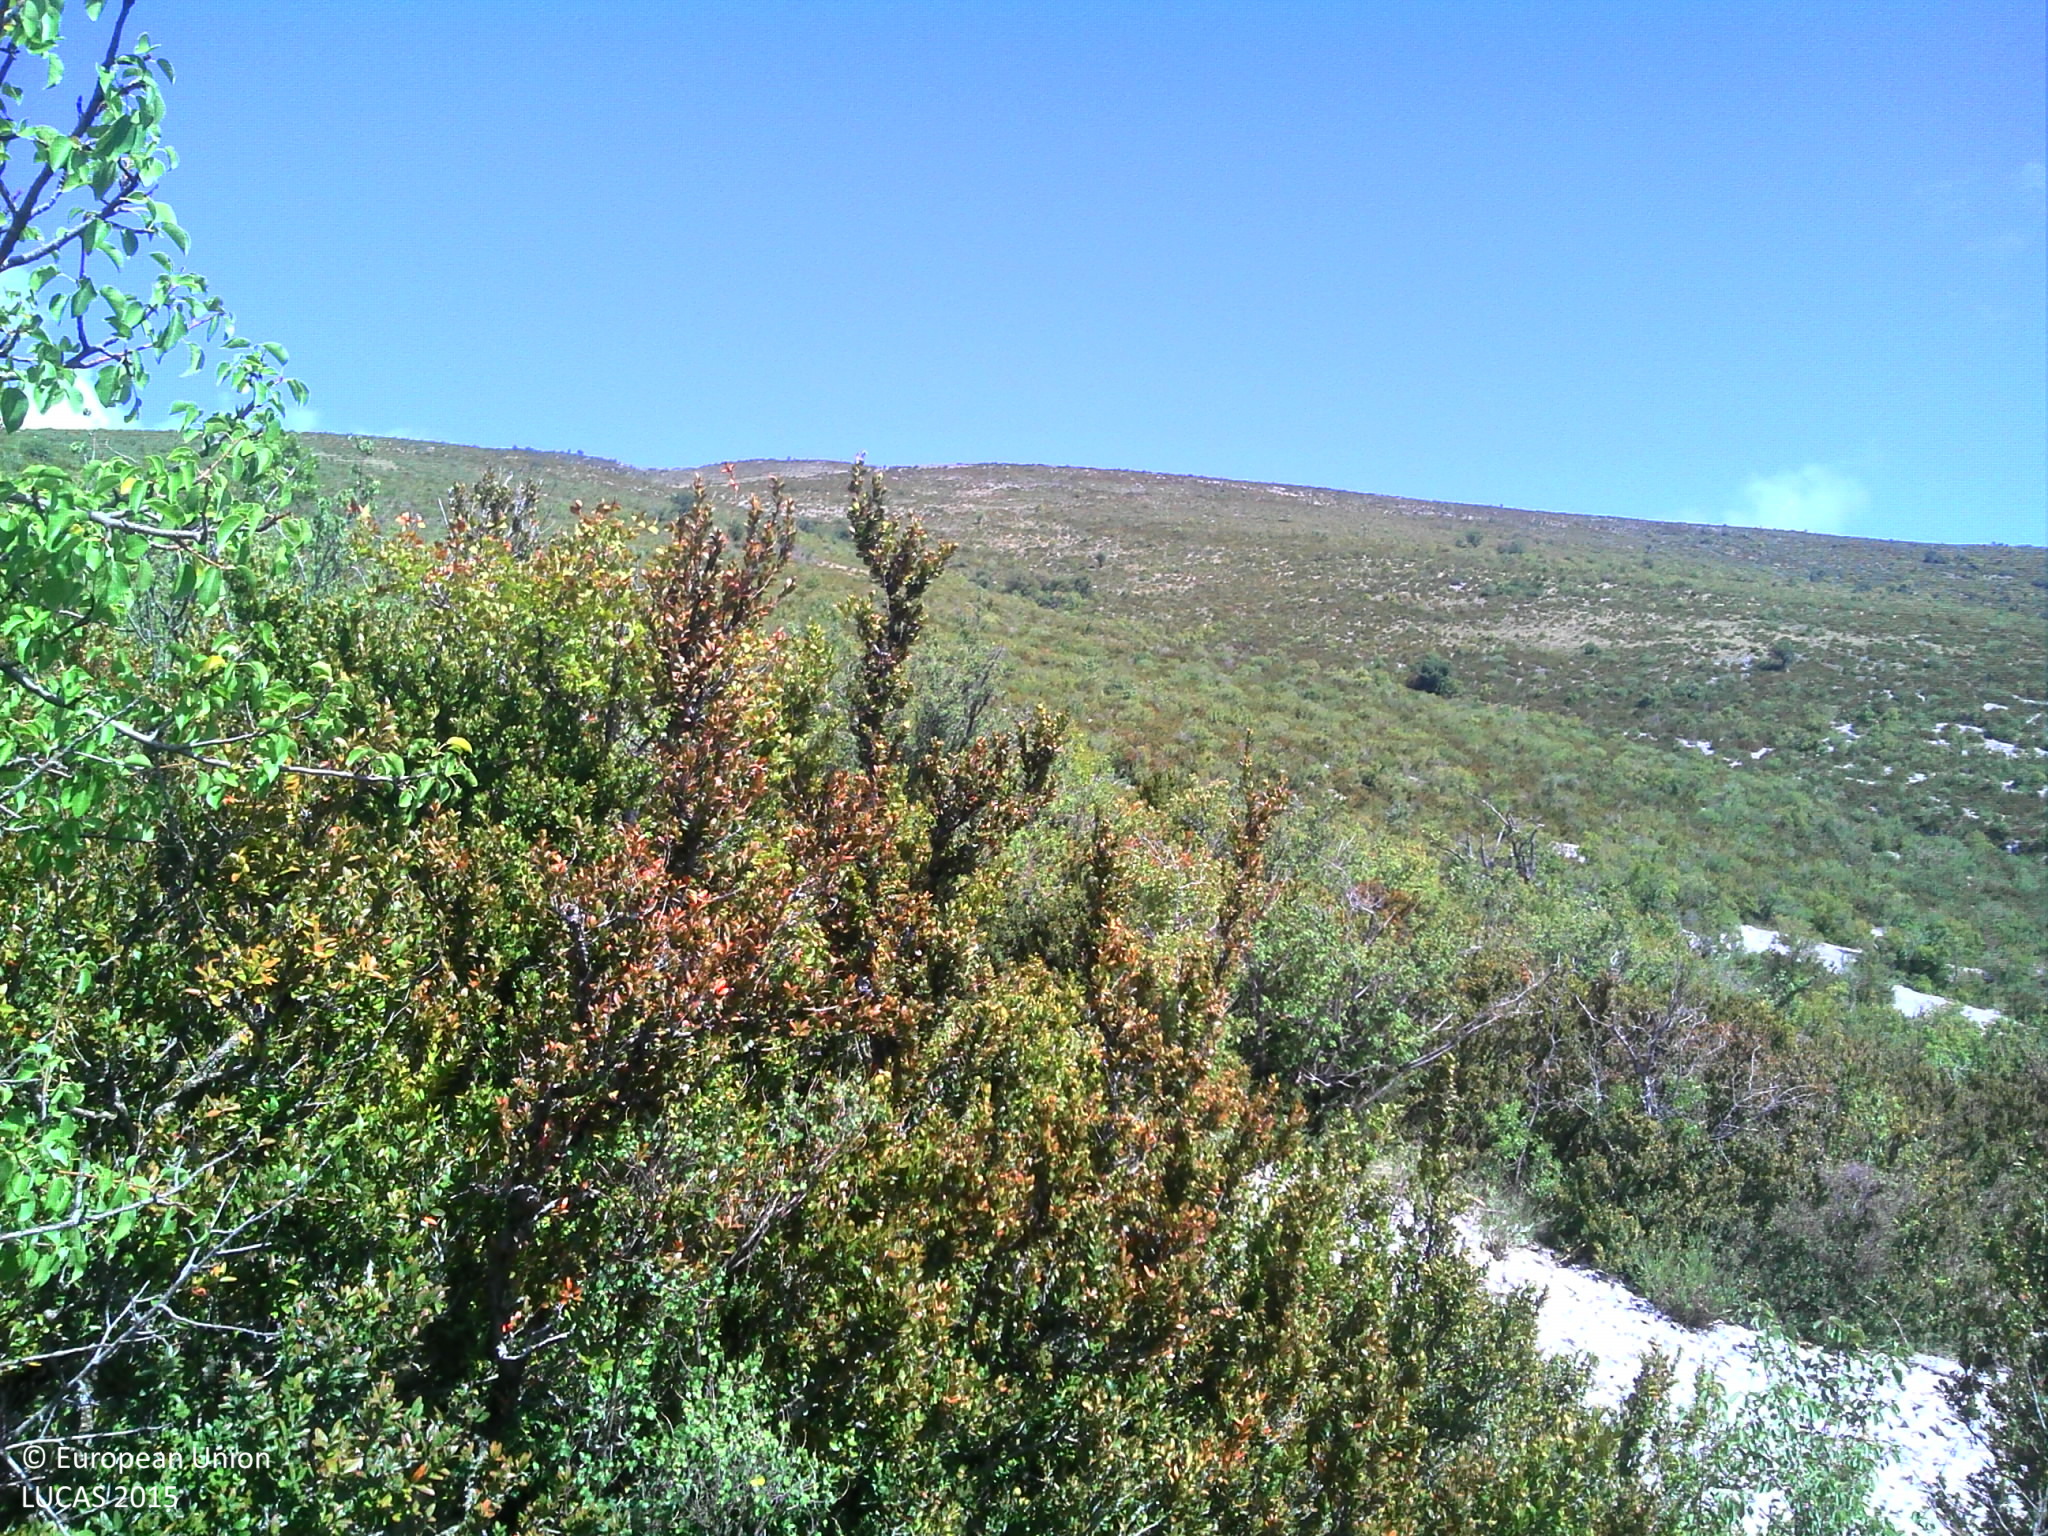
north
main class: Shrubland
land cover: Shrubland without tree cover
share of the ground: > 75 %
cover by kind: shrubs 90 %, unconsolidated bare surface 10 %
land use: Semi-natural and natural areas not in use
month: September
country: FR
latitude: 44.4594
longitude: 5.2689
